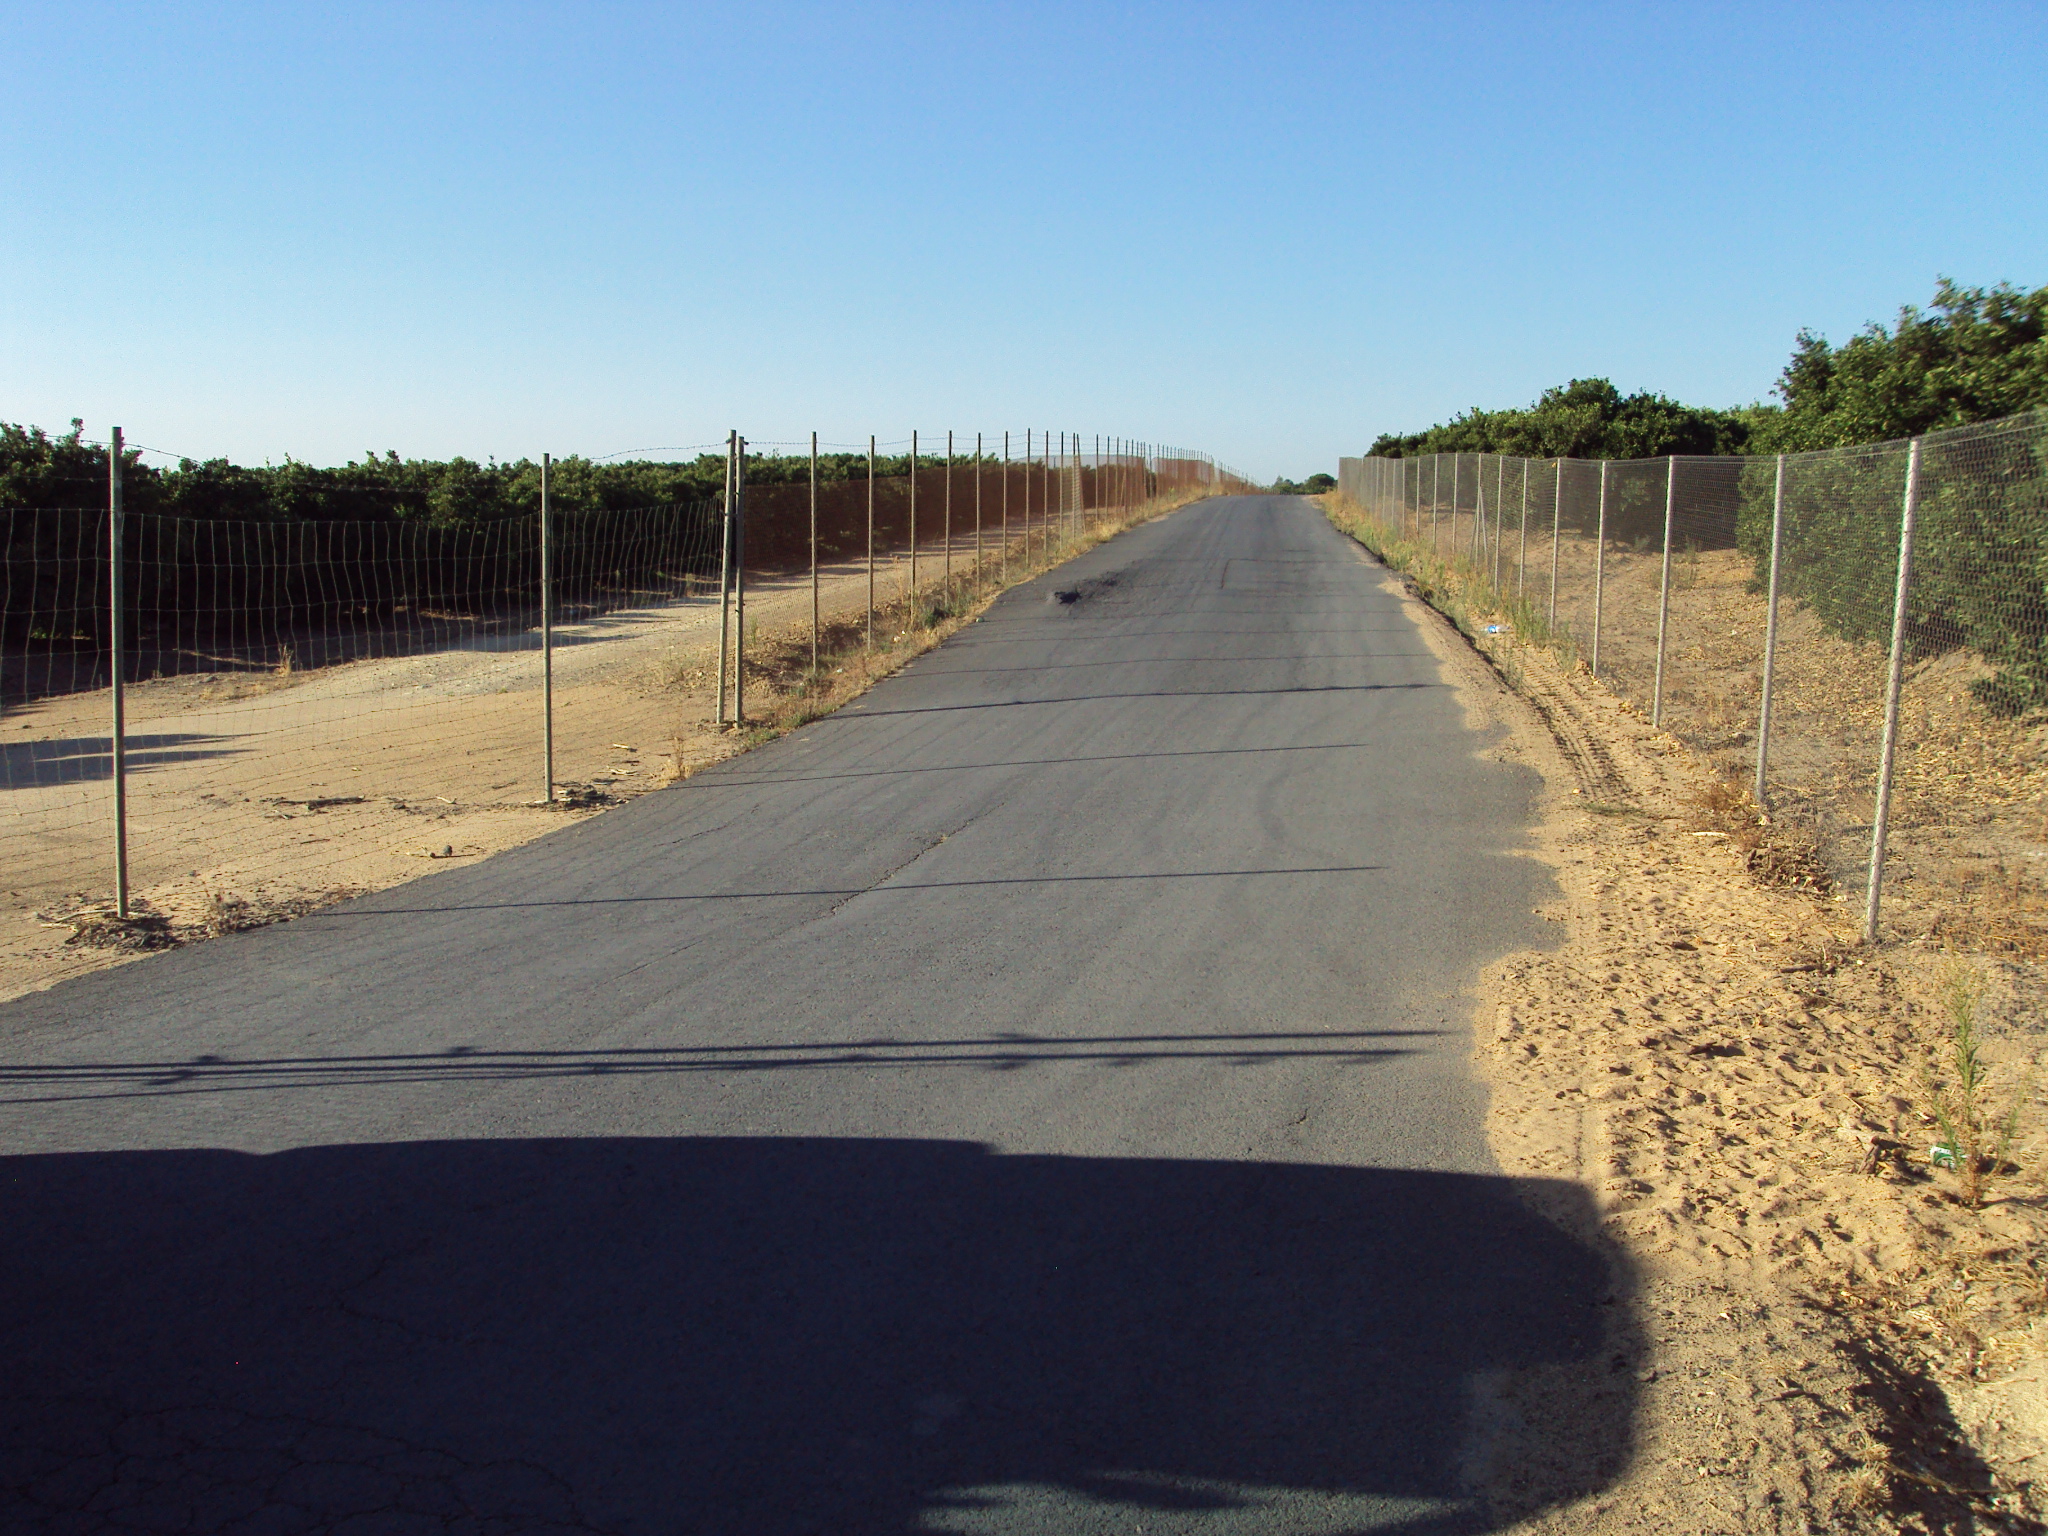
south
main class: Cropland
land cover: Oranges
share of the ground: > 75 %
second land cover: Other bare soil
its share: > 75 %
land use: Agriculture (excluding fallow land and kitchen gardens)
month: July
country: ES
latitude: 37.4153
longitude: -7.0480
